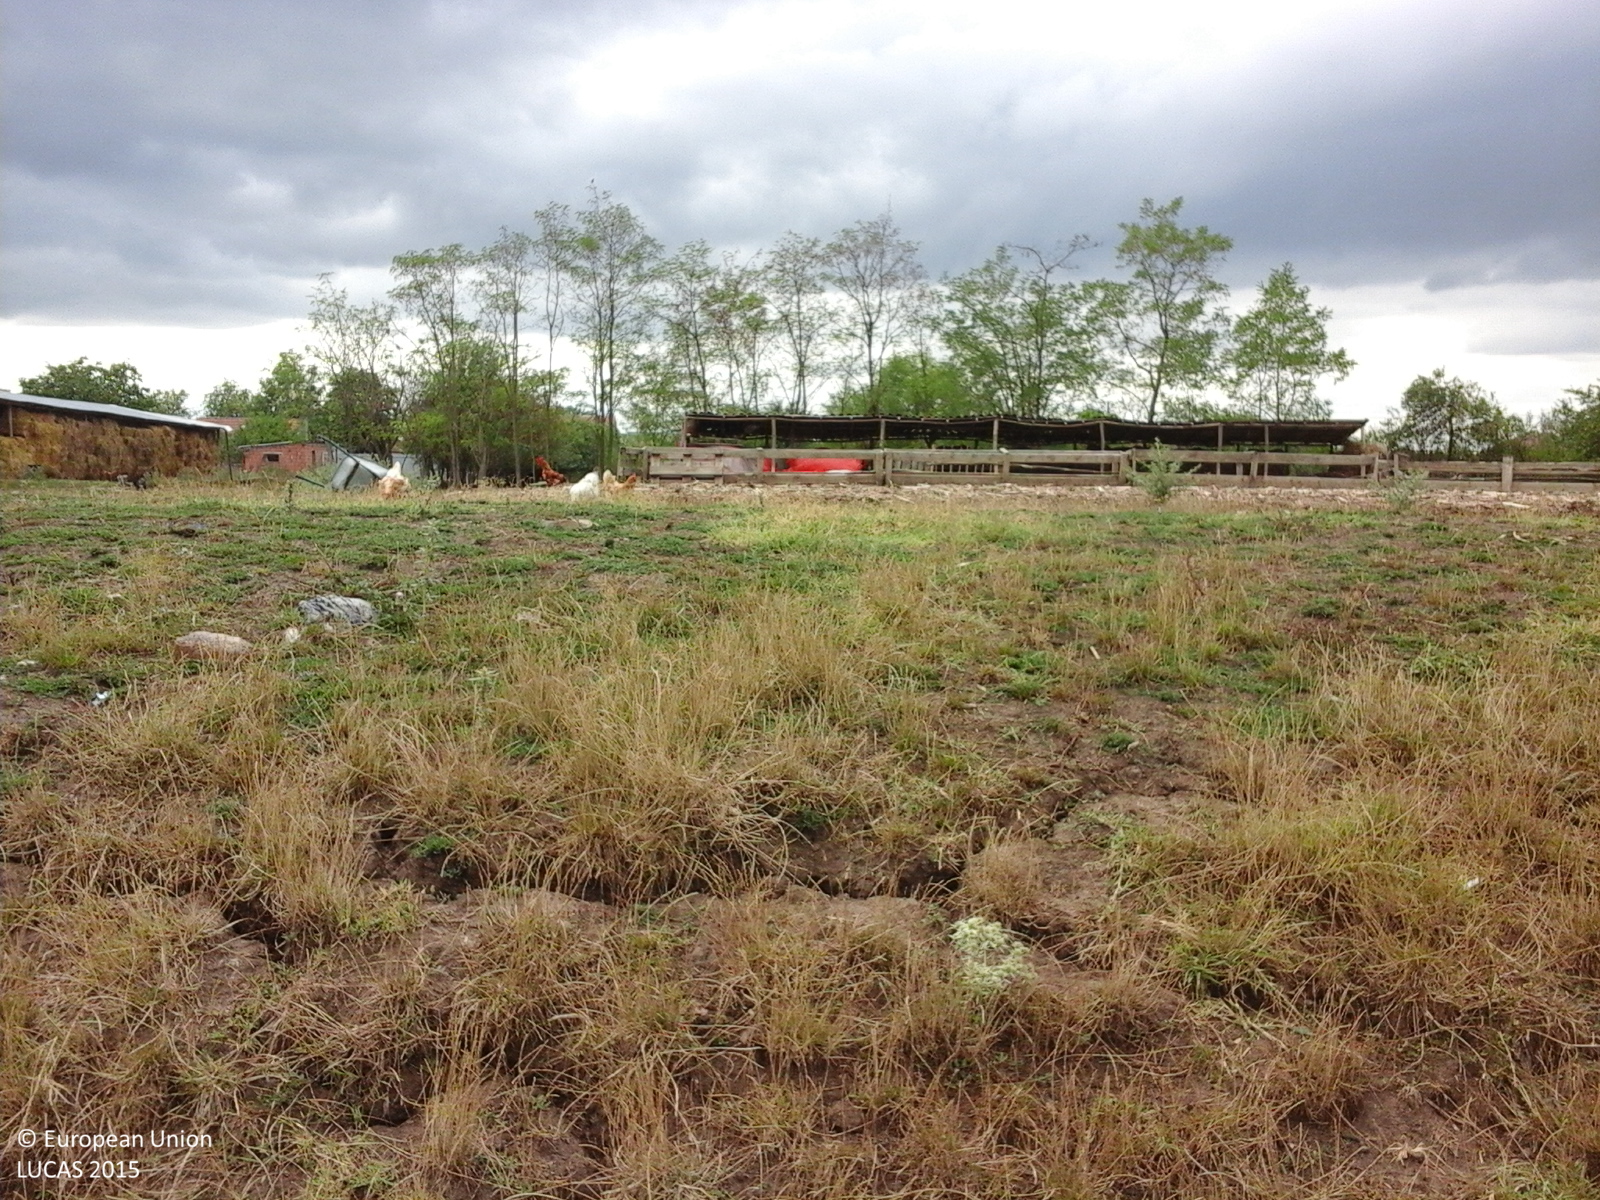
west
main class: Grassland
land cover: Grassland without tree/shrub cover
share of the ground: > 75 %
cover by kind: herbaceous plants 100 %
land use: Agriculture (excluding fallow land and kitchen gardens)
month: August
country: RO
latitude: 45.4528
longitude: 21.5278
